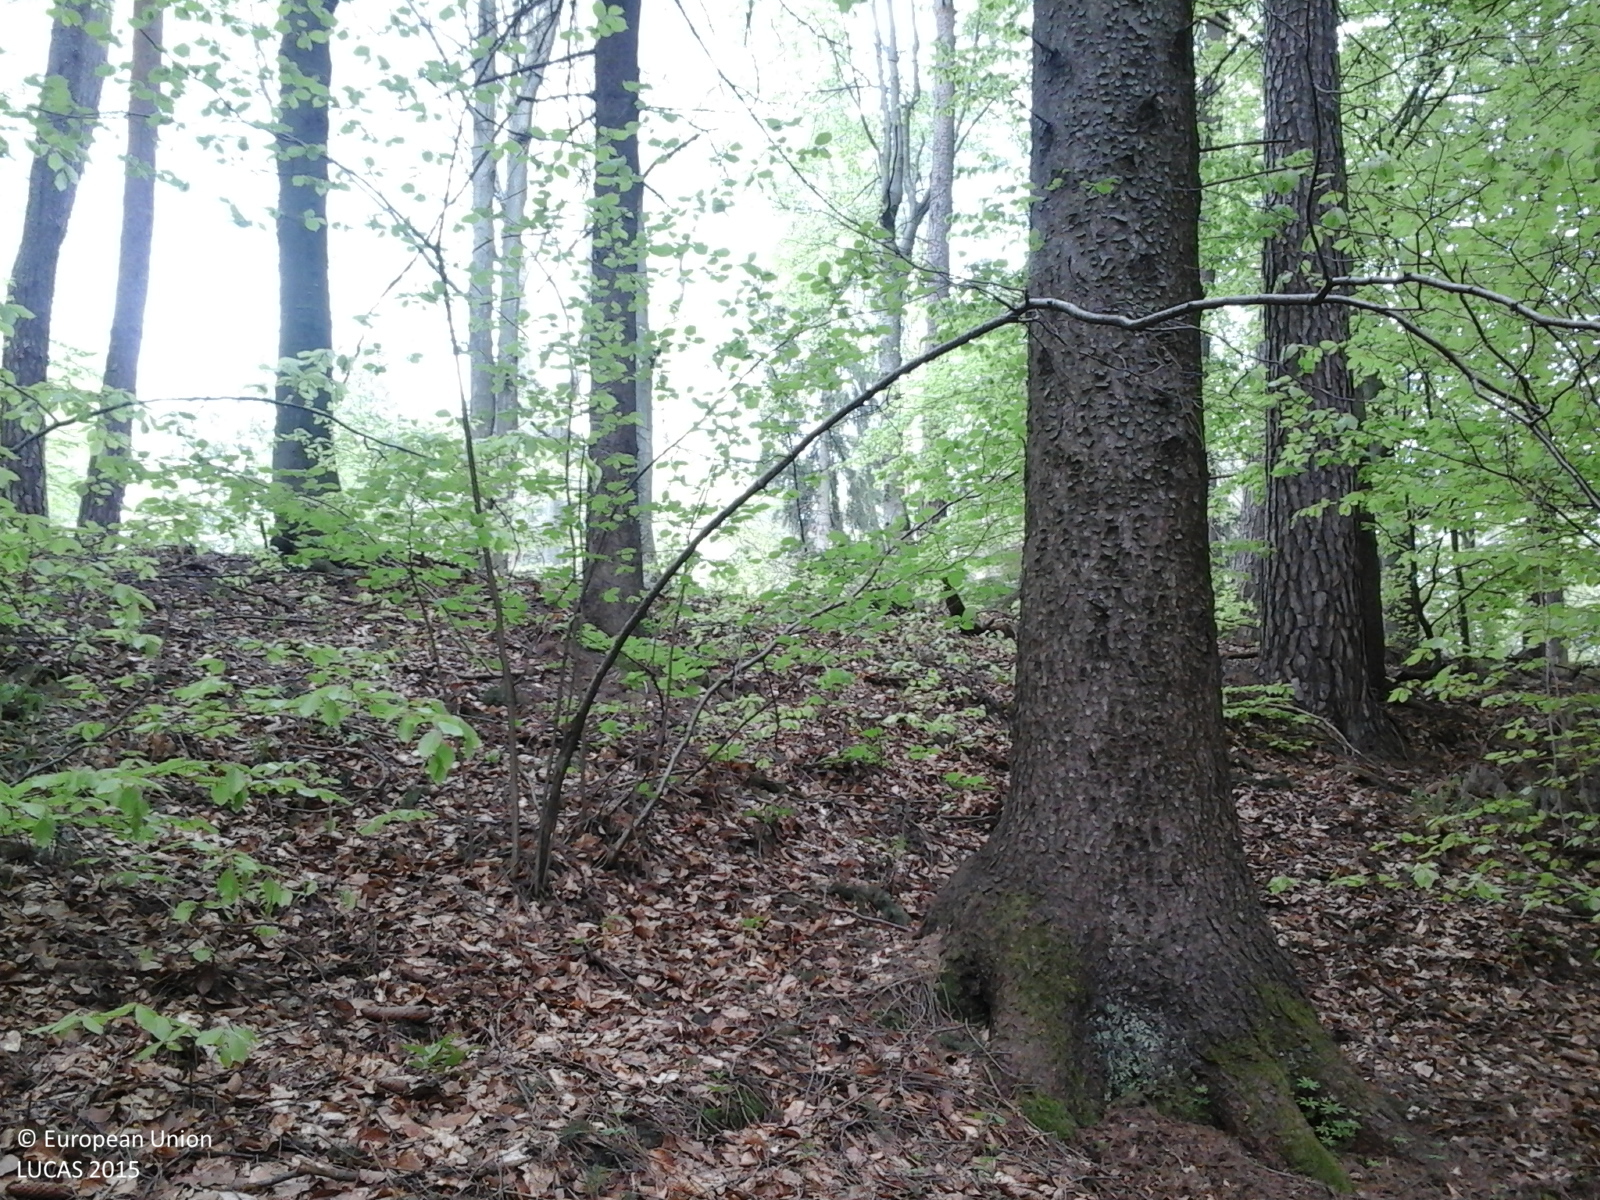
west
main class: Woodland
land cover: Other mixed woodland
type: beech forest
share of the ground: > 75 %
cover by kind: broadleaved forest trees 75 %, coniferous forest trees 25 %
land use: Forestry
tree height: > 5 m
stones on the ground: < 10 %
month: May
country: RO
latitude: 45.6255
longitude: 25.5588
